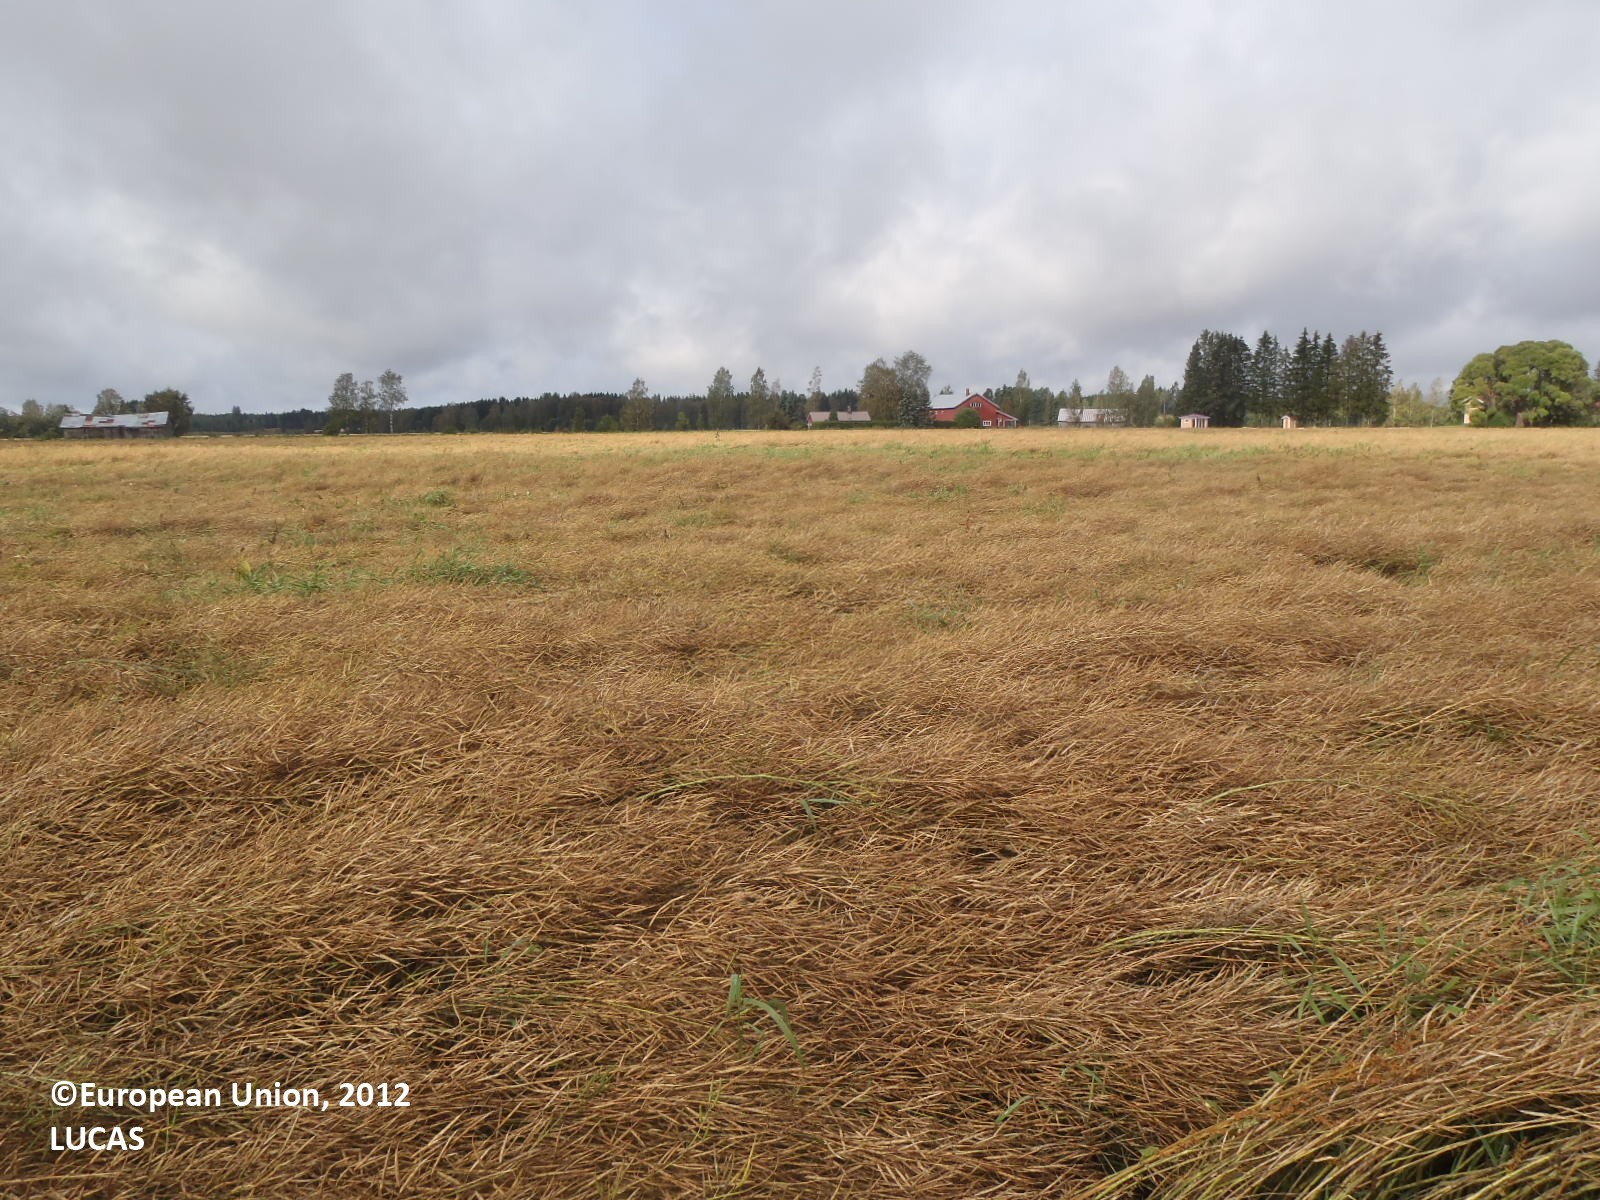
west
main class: Cropland
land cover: Rape and turnip rape
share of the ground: > 75 %
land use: Agriculture (excluding fallow land and kitchen gardens)
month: September
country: FI
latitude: 60.9672
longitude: 22.5737
